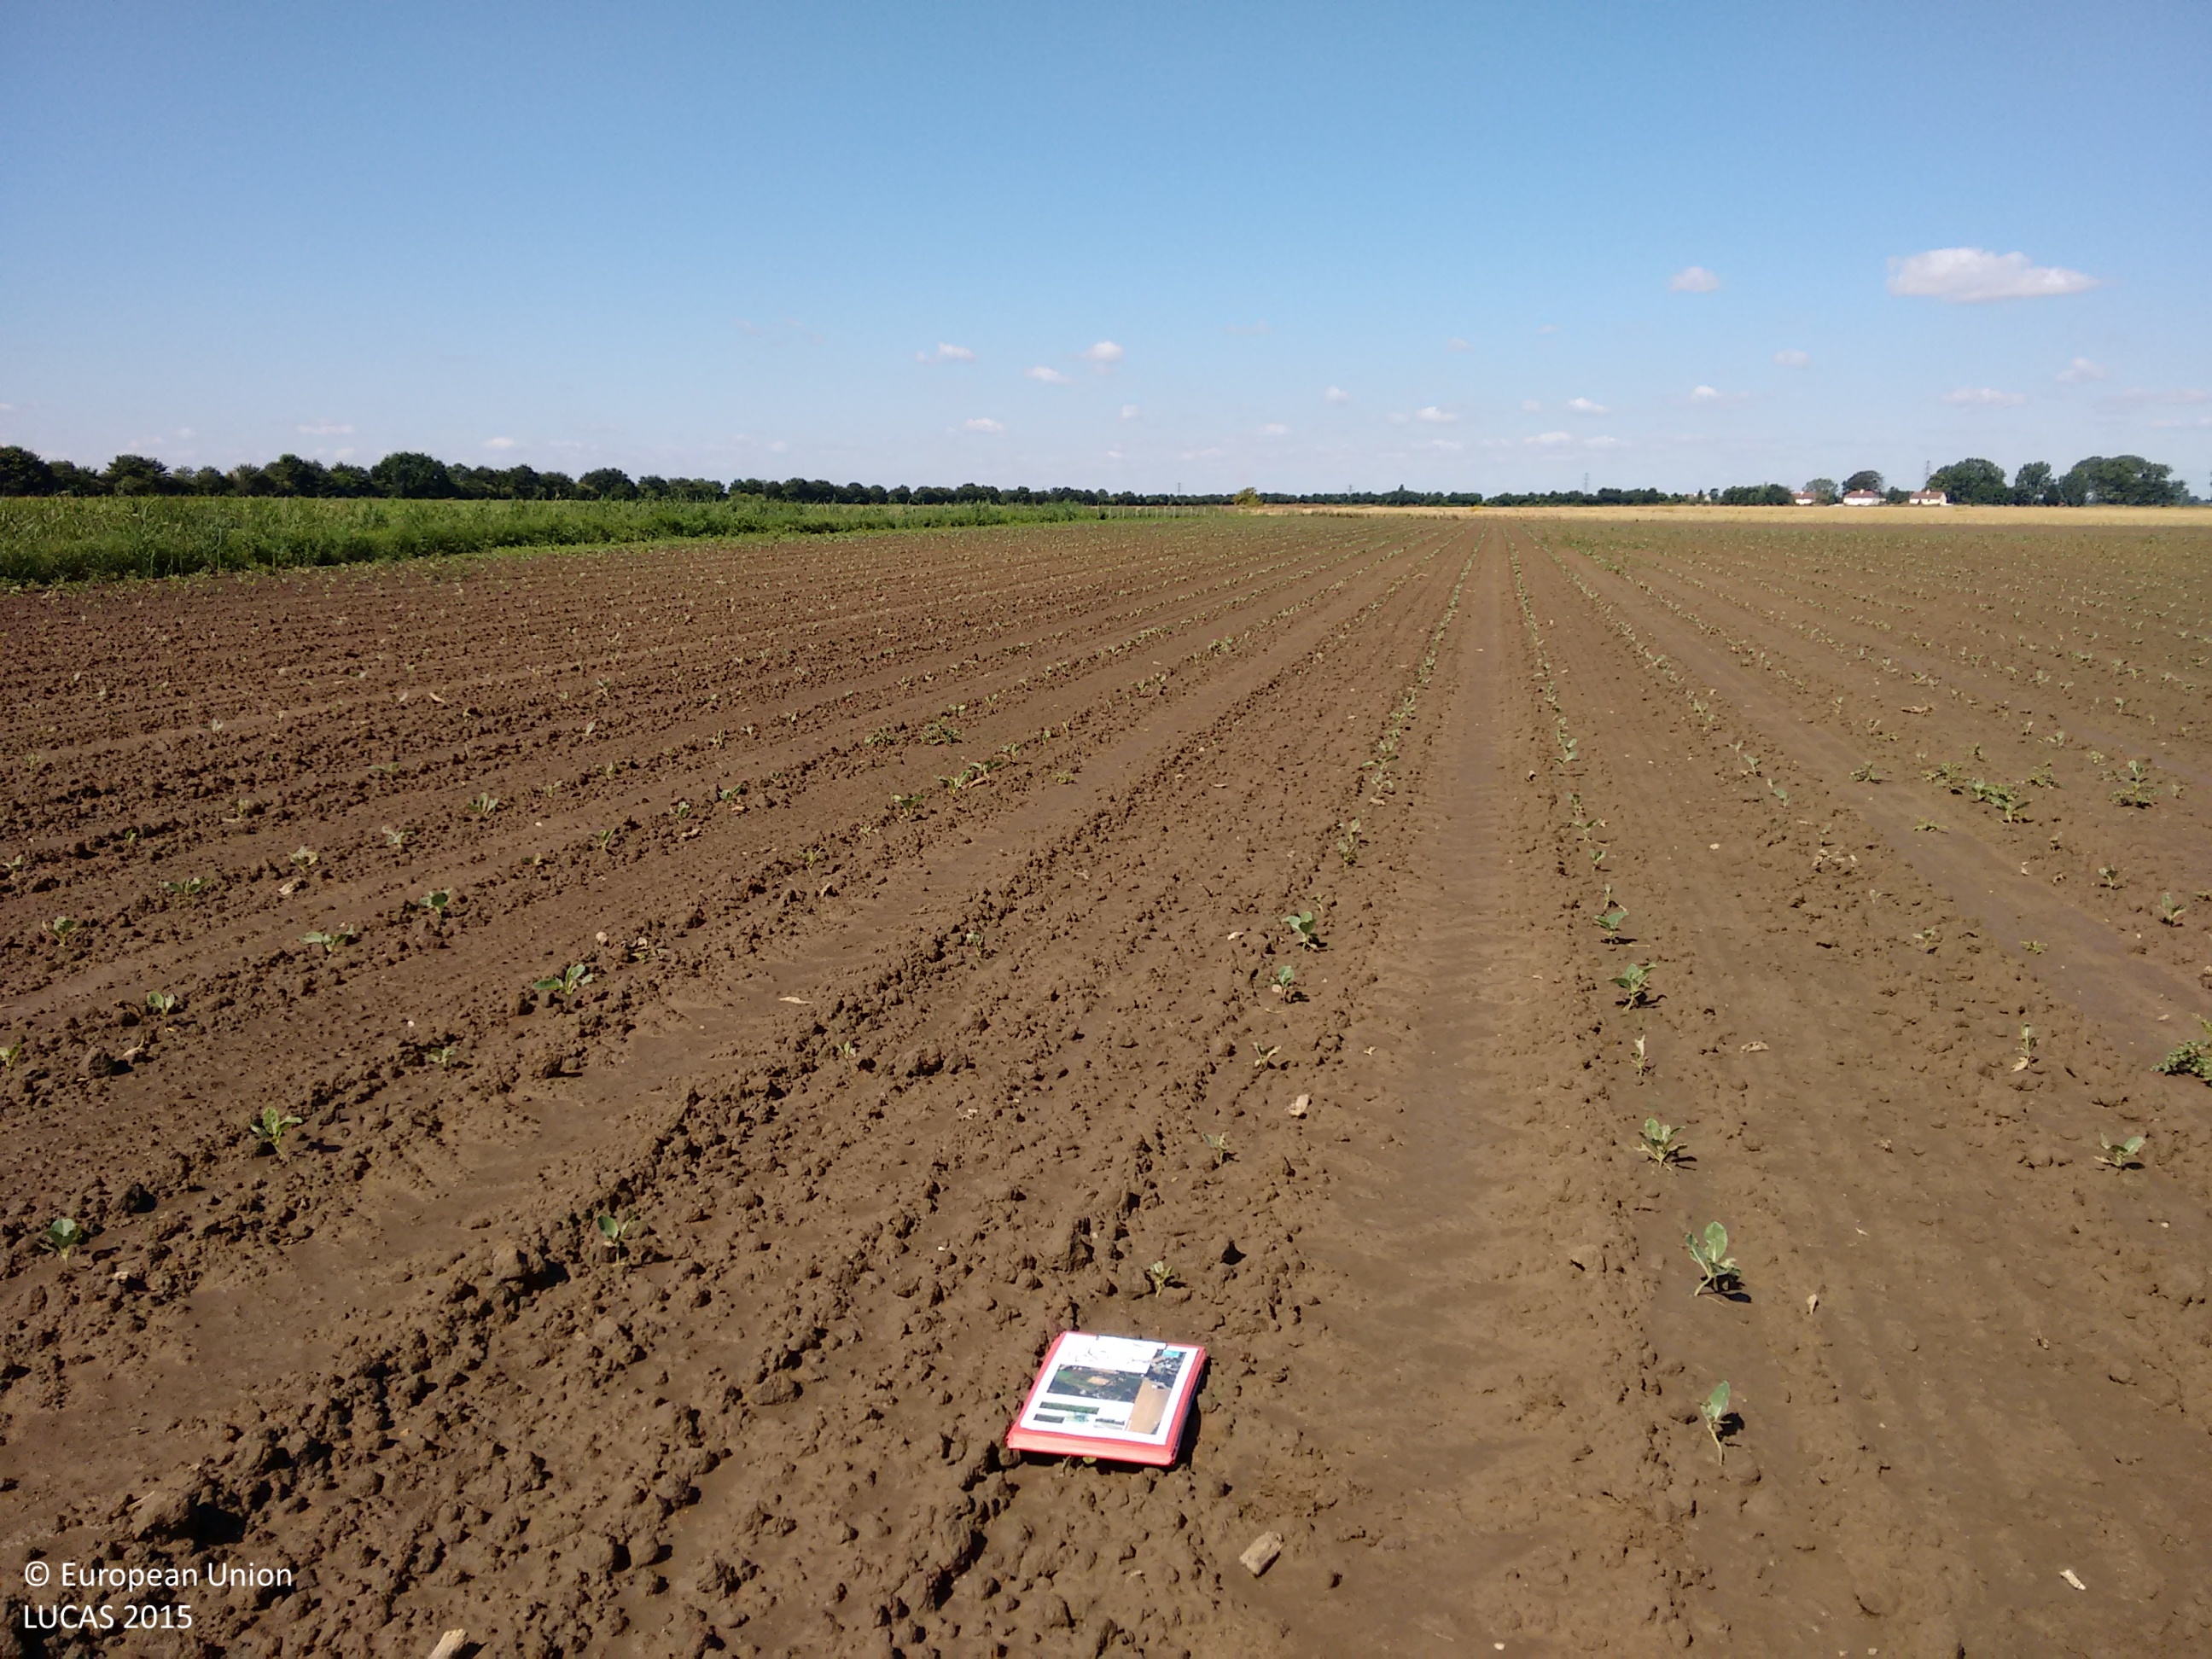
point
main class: Cropland
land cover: Other fresh vegetables
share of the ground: < 10 %
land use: Agriculture (excluding fallow land and kitchen gardens)
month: July
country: GB
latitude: 52.6187
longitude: 0.1466
